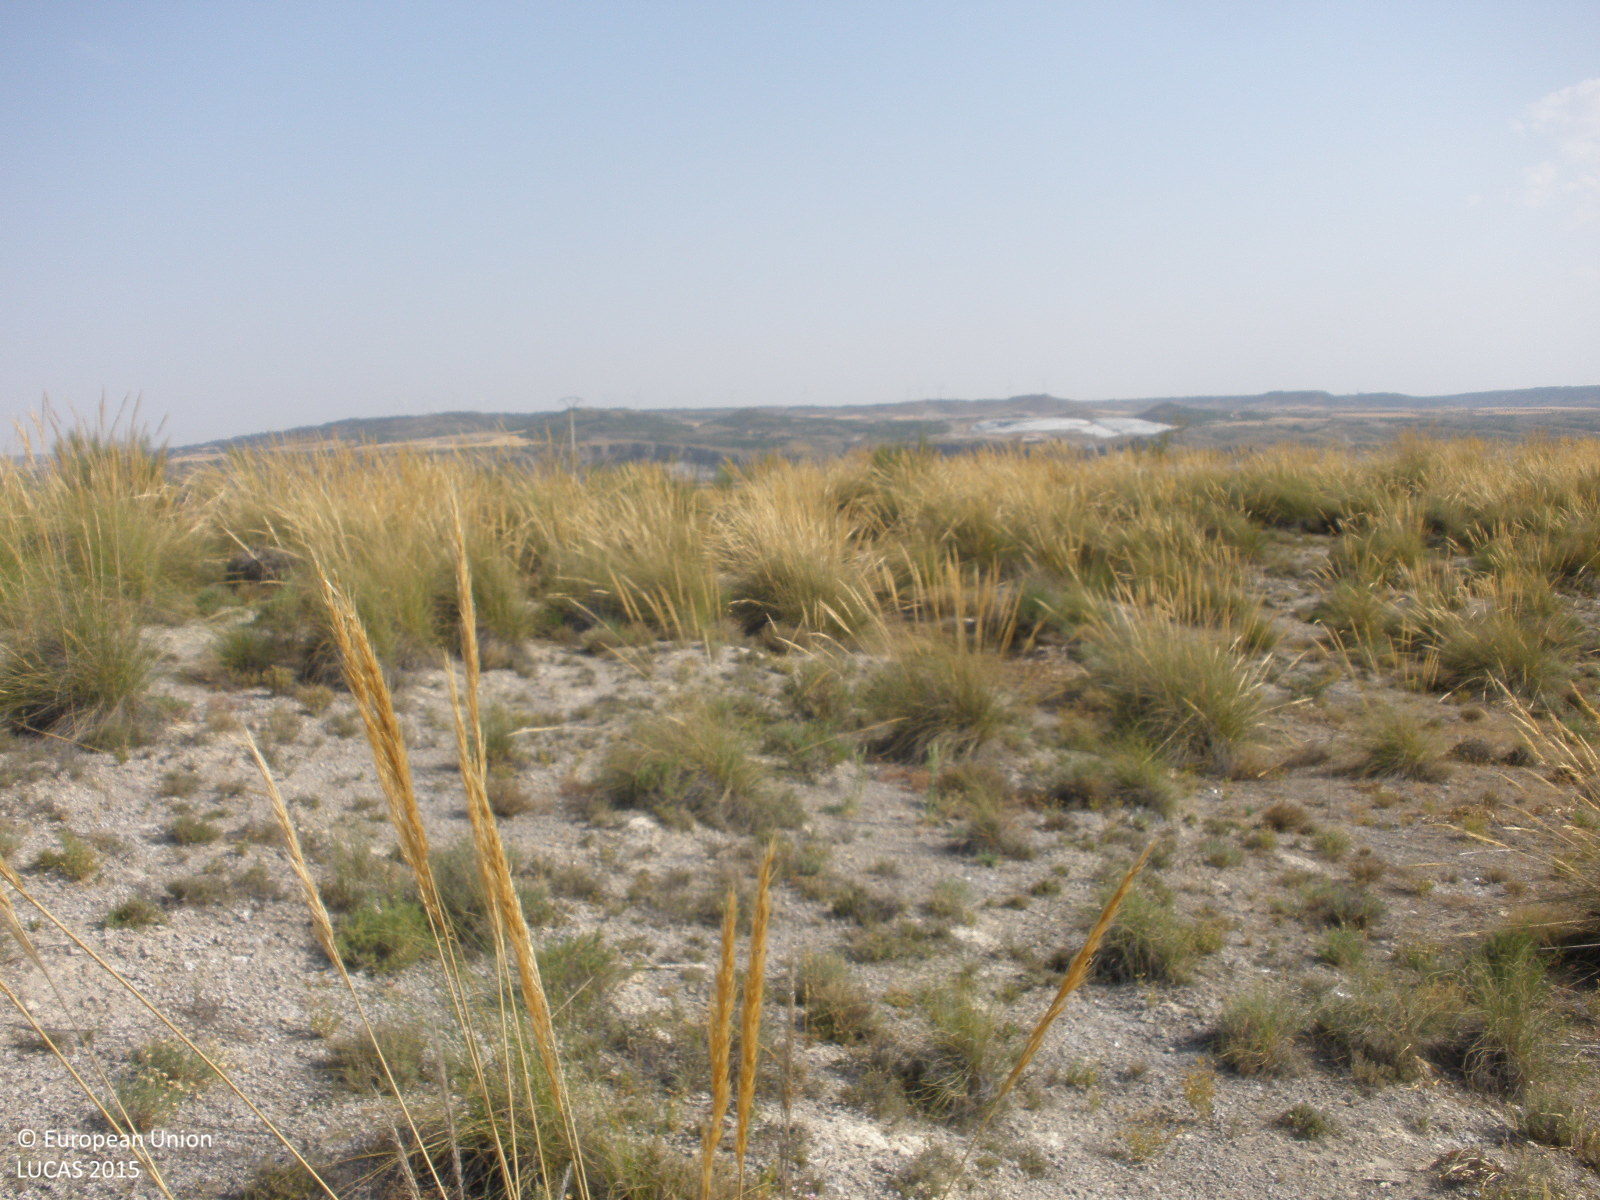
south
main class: Shrubland
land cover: Shrubland without tree cover
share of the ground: 25 - 50 %
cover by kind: shrubs 40 %, herbaceous plants 30 %, consolidated bare surface 30 %
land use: Semi-natural and natural areas not in use
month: July
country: ES
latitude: 40.0633
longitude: -3.3589
